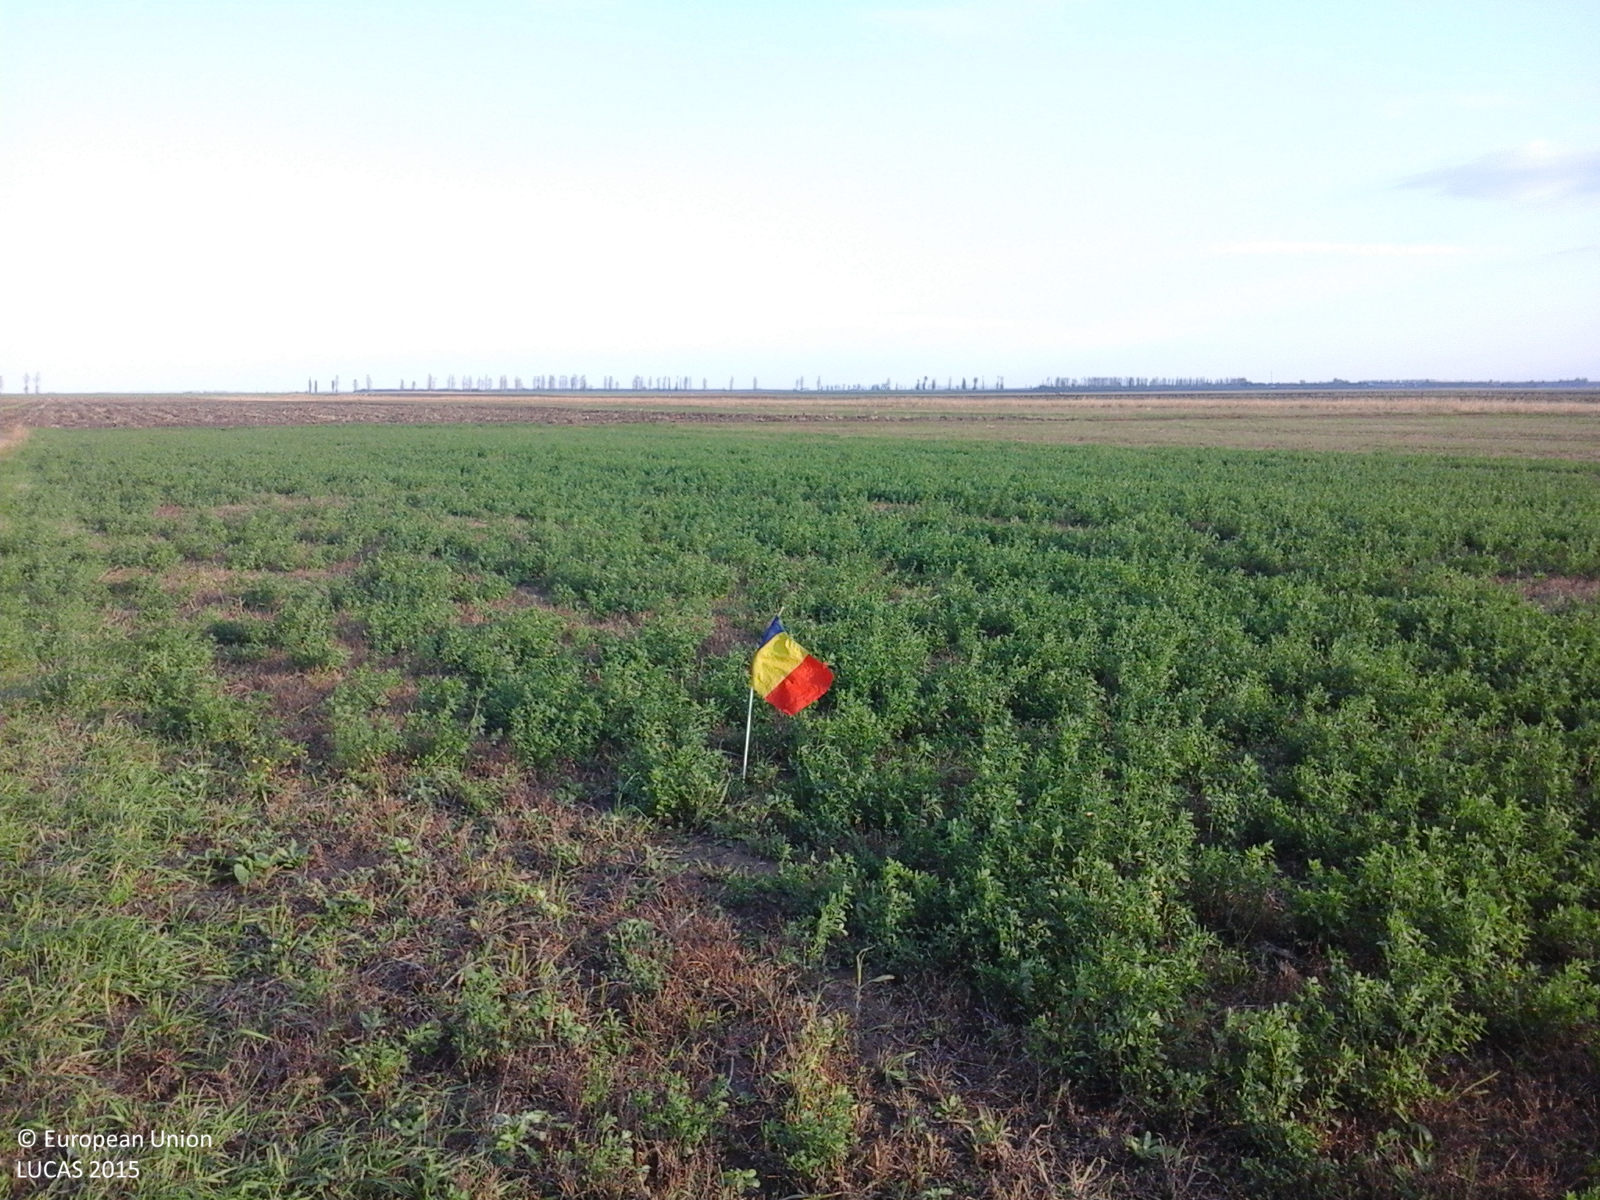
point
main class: Cropland
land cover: Lucerne
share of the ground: > 75 %
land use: Agriculture (excluding fallow land and kitchen gardens)
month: October
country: RO
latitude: 45.3201
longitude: 27.0417
